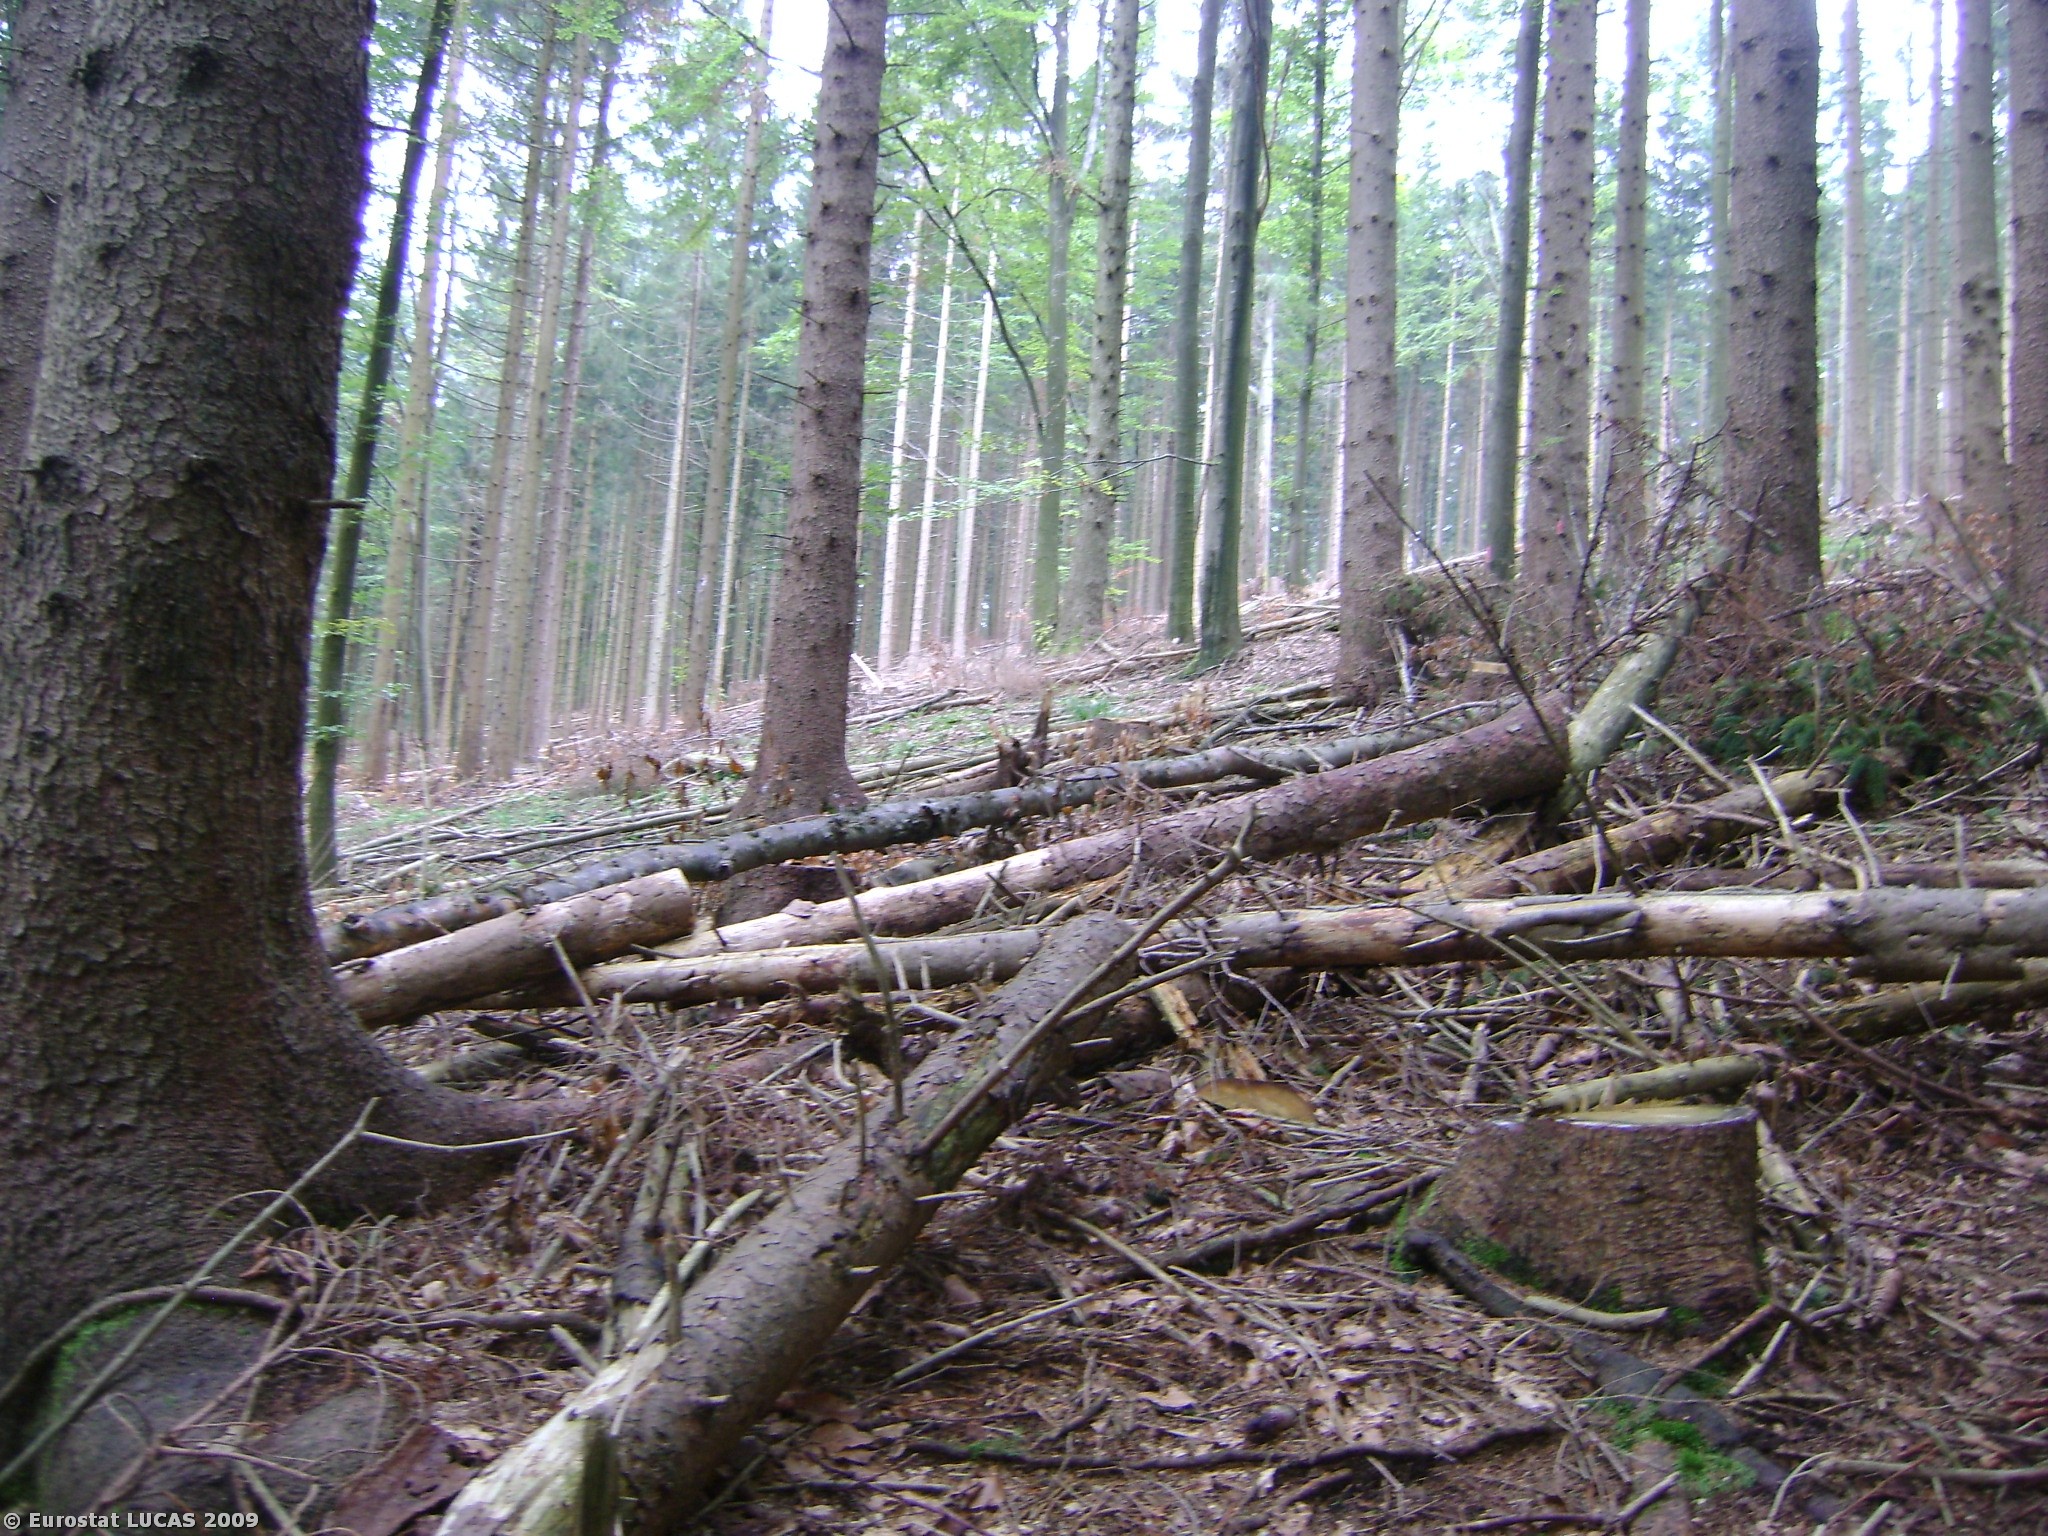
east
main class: Woodland
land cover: Mixed woodland
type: hemiboreal forest and nemoral coniferous forest and mixed broadleaved-coniferous forest
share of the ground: > 75 %
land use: Forestry
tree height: > 5 m
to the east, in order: Mixed woodland; Ditches and canals; Mixed woodland; Coniferous woodland; Ditches and canals; Coniferous woodland; Ditches and canals; Coniferous woodland; Mixed woodland; Ditches and canals; Mixed woodland
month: August
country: AT
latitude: 47.9055
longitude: 13.2497
